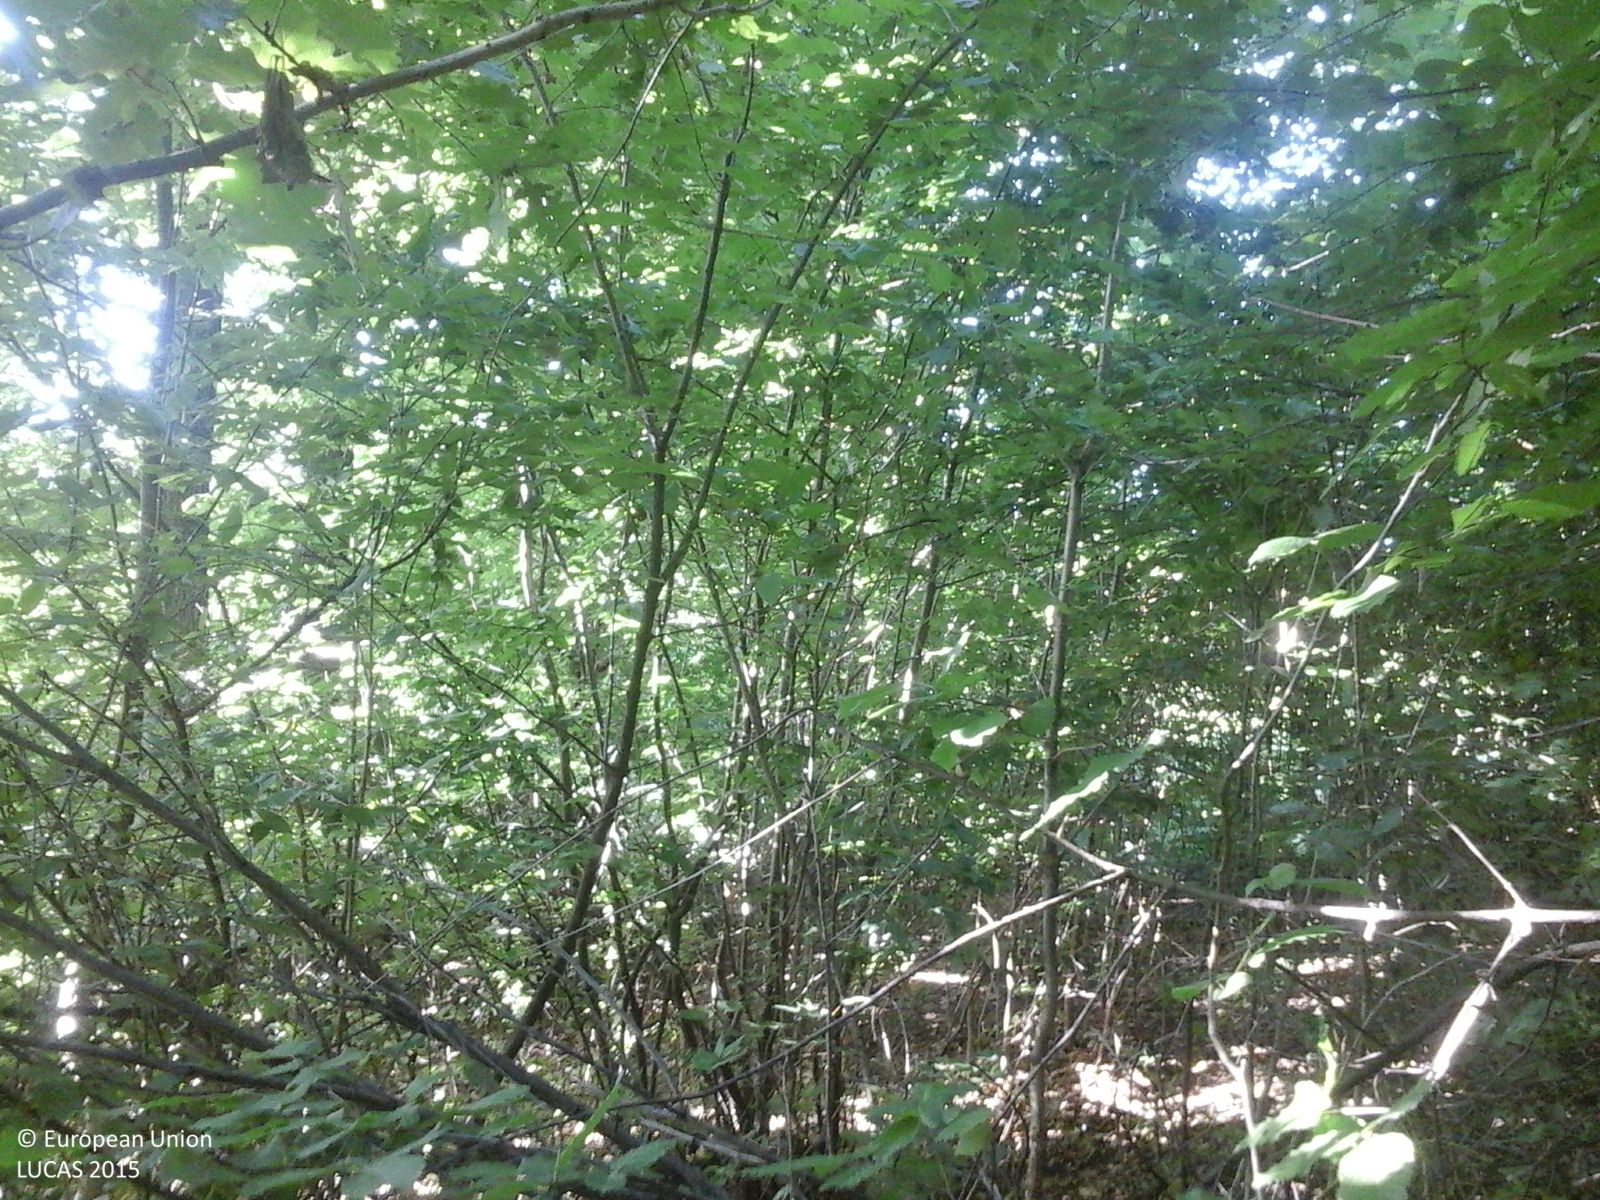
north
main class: Woodland
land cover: Broadleaved woodland
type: acidophilous oak and oak-birch forest
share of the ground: > 75 %
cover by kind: broadleaved forest trees 100 %
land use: Forestry
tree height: > 5 m
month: June
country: RO
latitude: 45.1208
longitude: 26.2217
